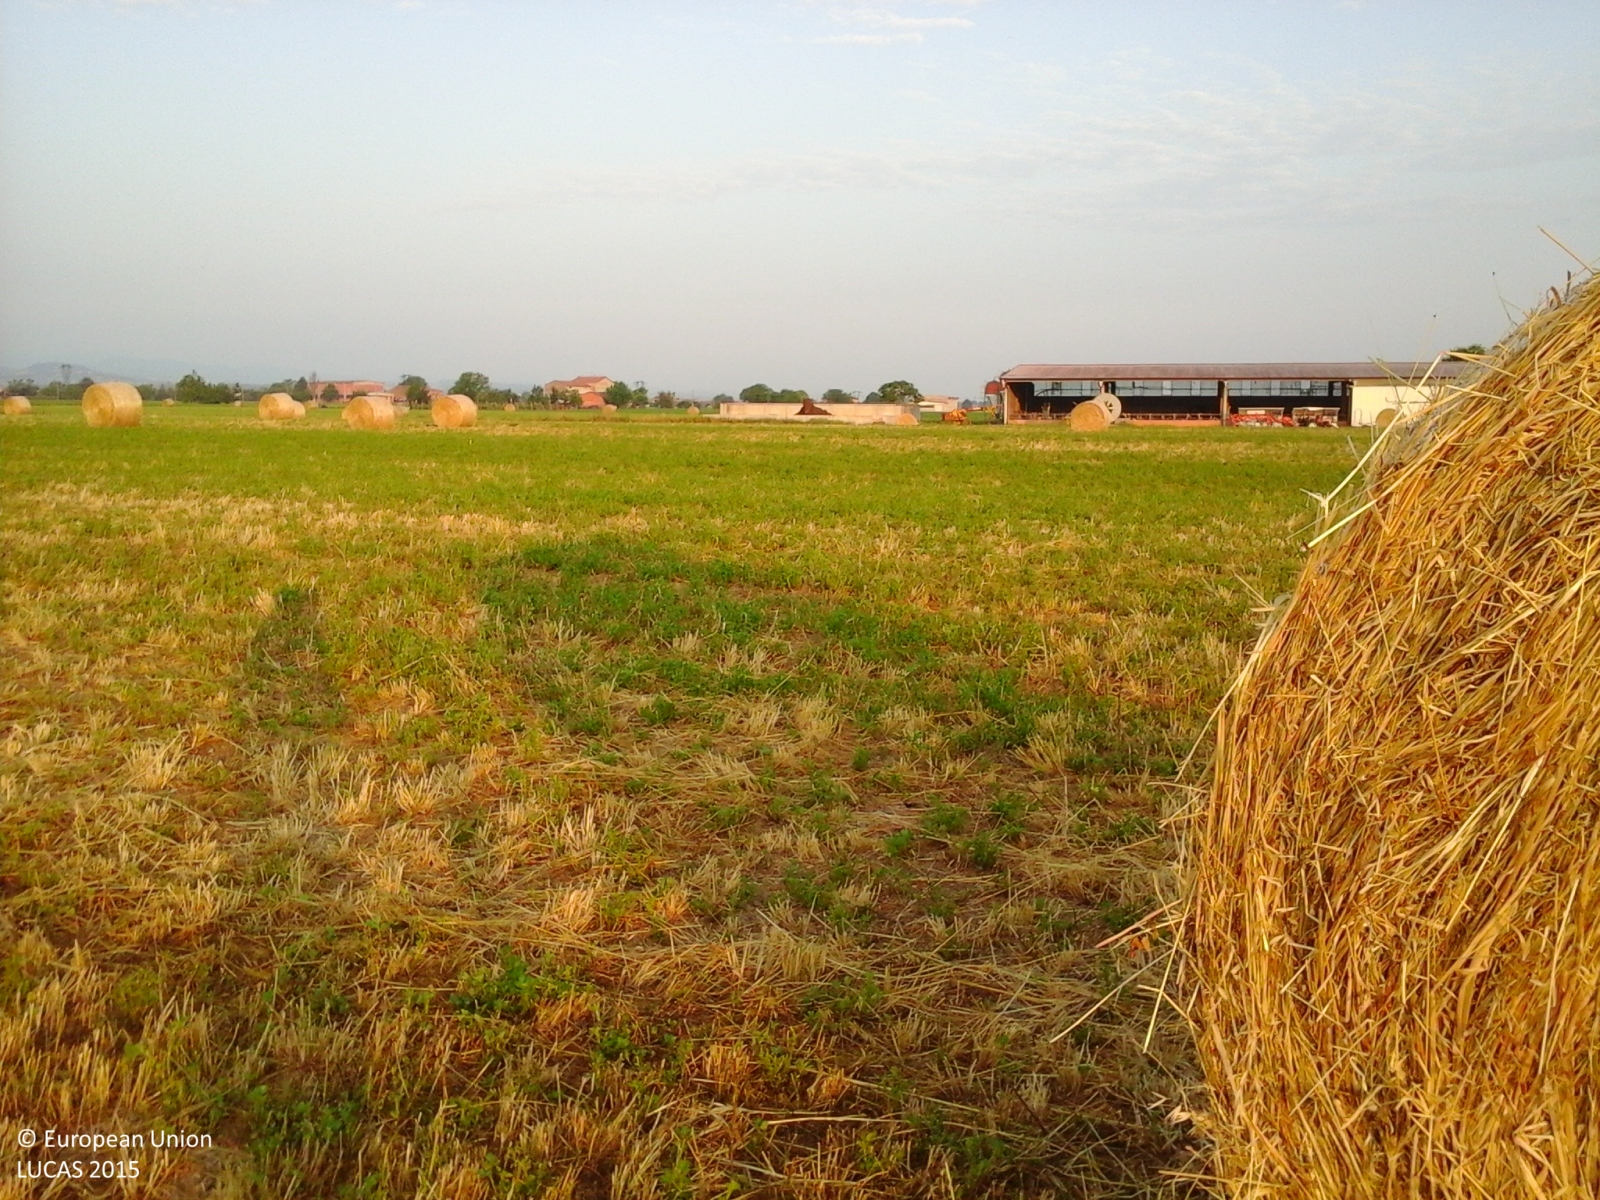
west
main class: Grassland
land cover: Spontaneously vegetated surfaces
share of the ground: 10 - 25 %
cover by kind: unconsolidated bare surface 90 %, herbaceous plants 10 %
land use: Agriculture (excluding fallow land and kitchen gardens)
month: June
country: IT
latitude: 44.8915
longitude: 10.0632
